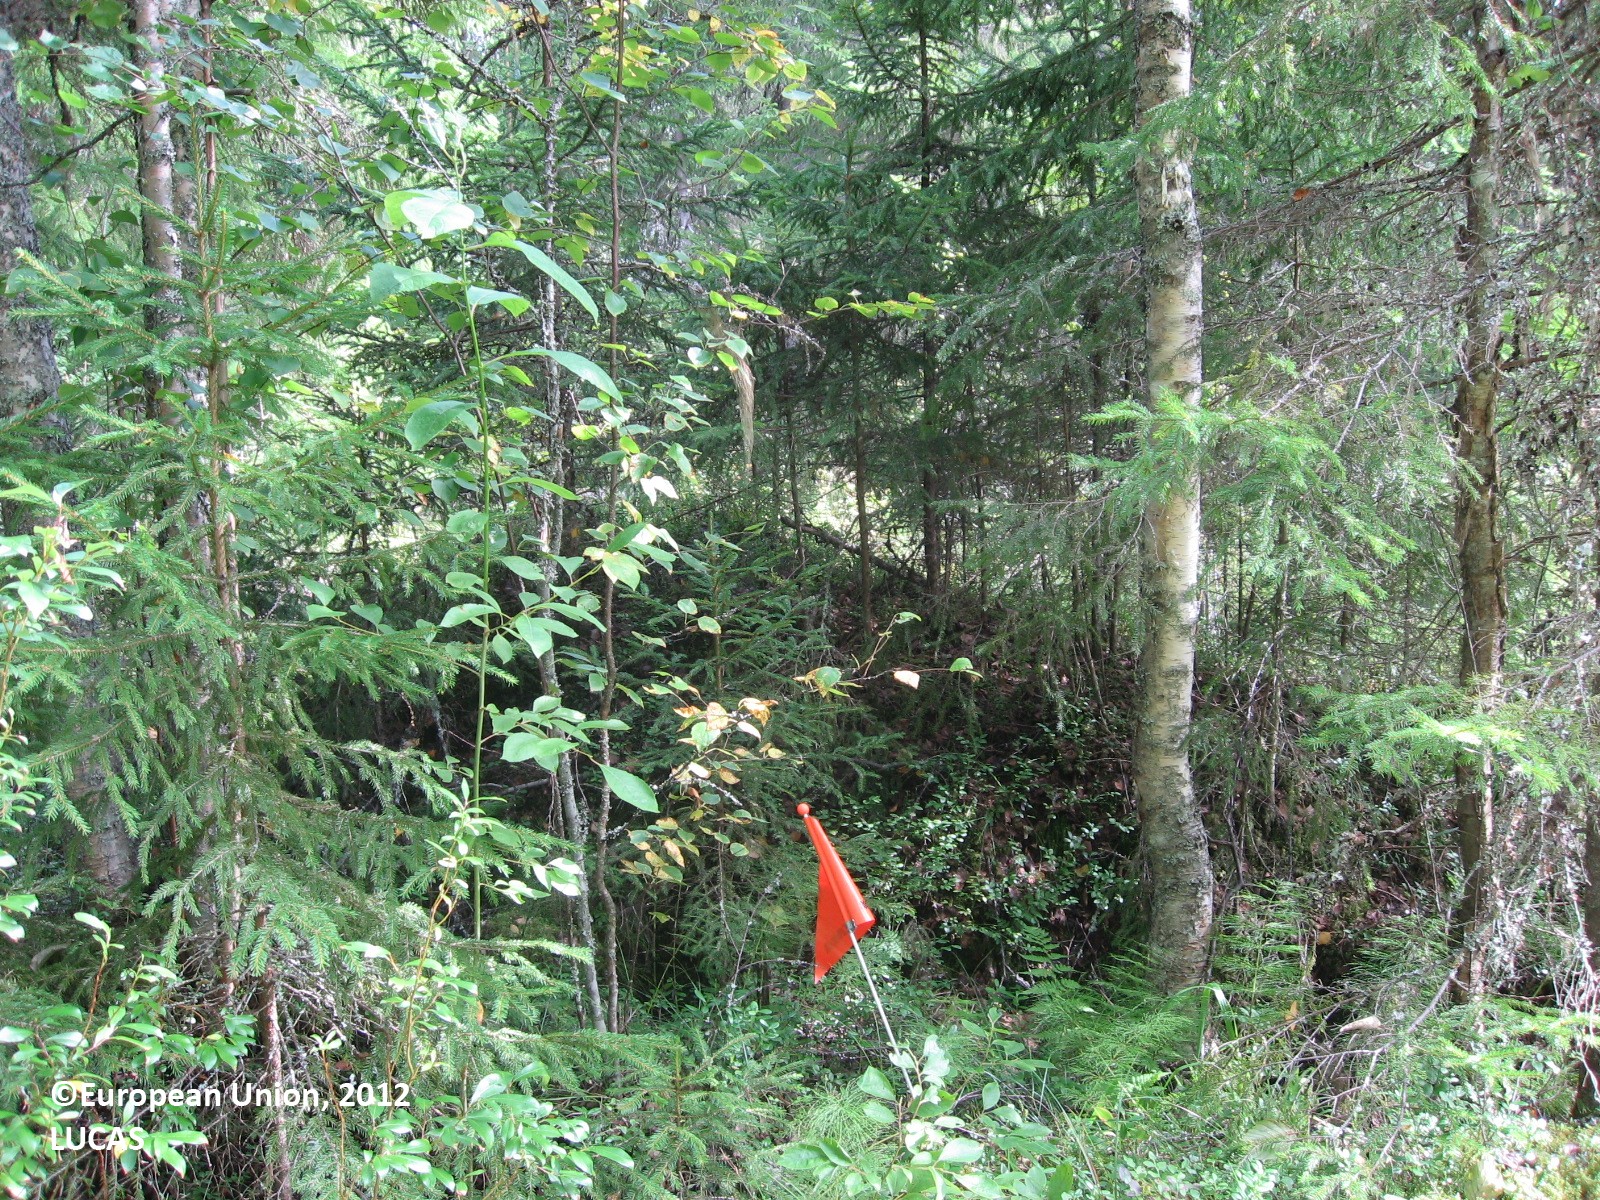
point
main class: Woodland
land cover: Spruce dominated mixed woodland
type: boreal forest
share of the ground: > 75 %
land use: Forestry
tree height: > 5 m
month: August
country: FI
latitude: 61.3323
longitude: 24.8892
